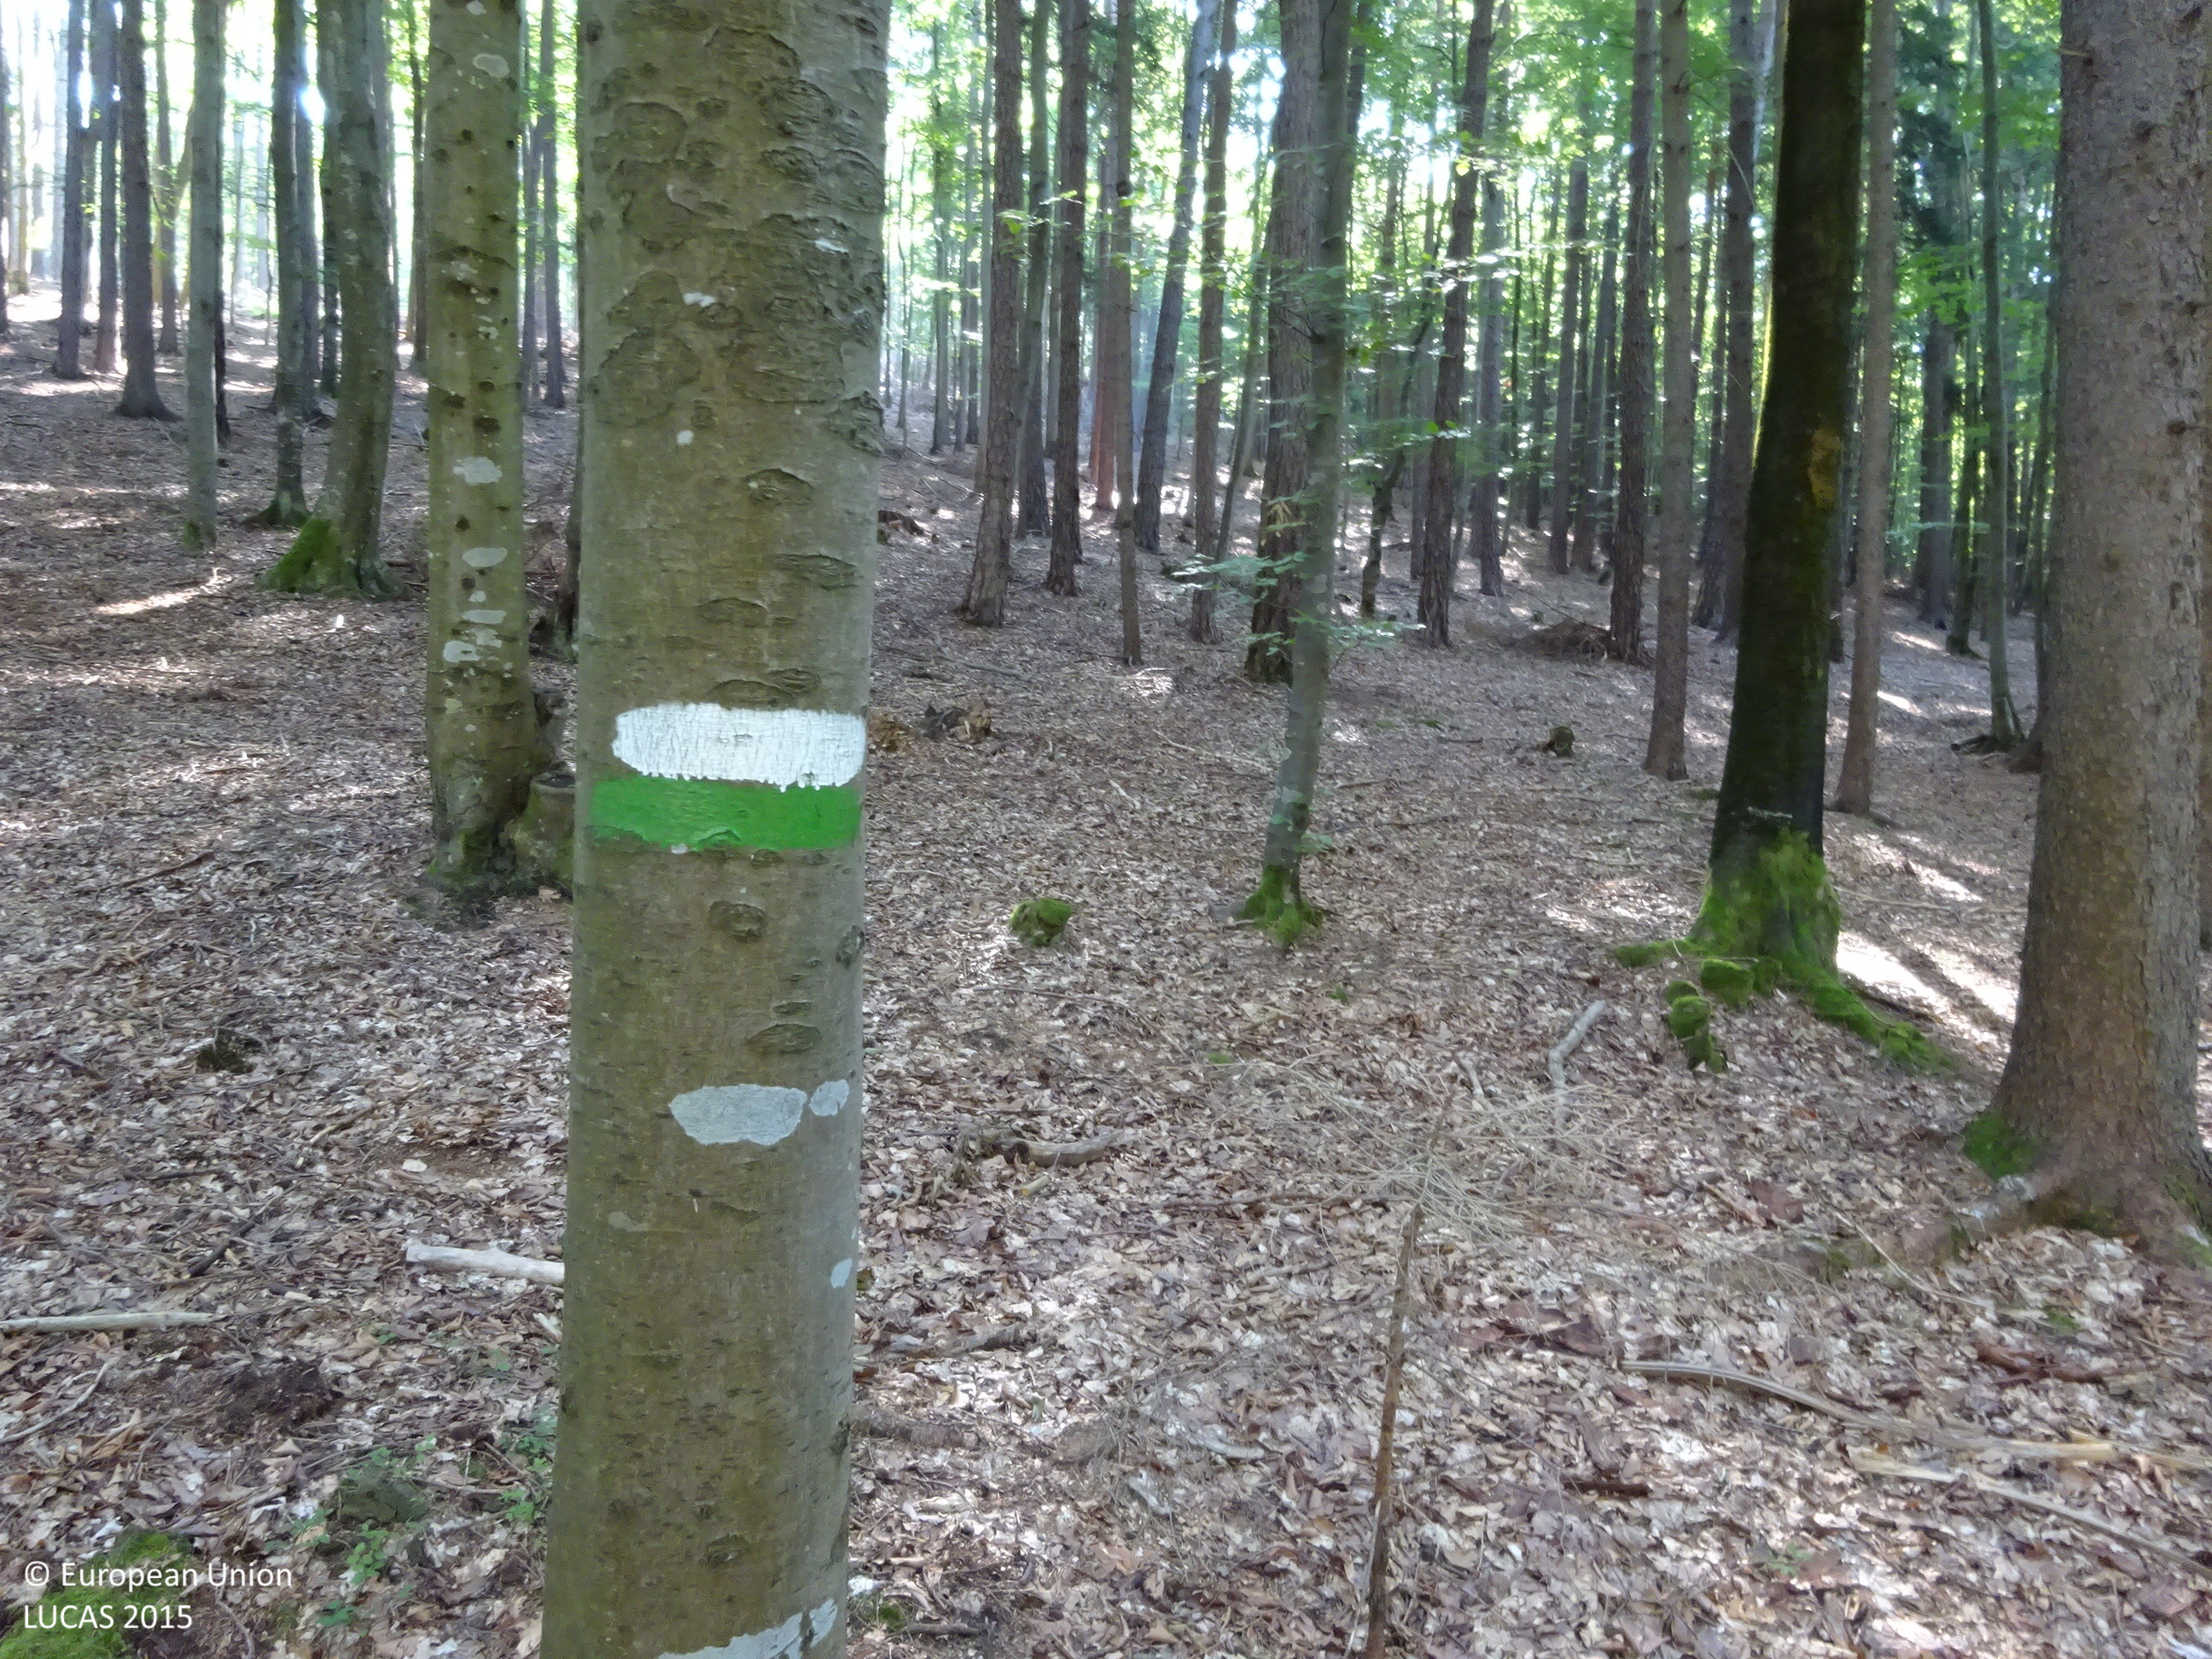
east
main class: Woodland
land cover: Pine dominated mixed woodland
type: hemiboreal forest and nemoral coniferous forest and mixed broadleaved-coniferous forest
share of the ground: > 75 %
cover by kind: broadleaved forest trees 75 %, coniferous forest trees 25 %
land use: Forestry
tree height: > 5 m
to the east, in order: Tracks; Pine dominated mixed woodland; Spruce dominated coniferous woodland; Pine dominated coniferous woodland; Pine dominated mixed woodland; Tracks; Pine dominated mixed woodland
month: August
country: AT
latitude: 47.4207
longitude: 16.1396
